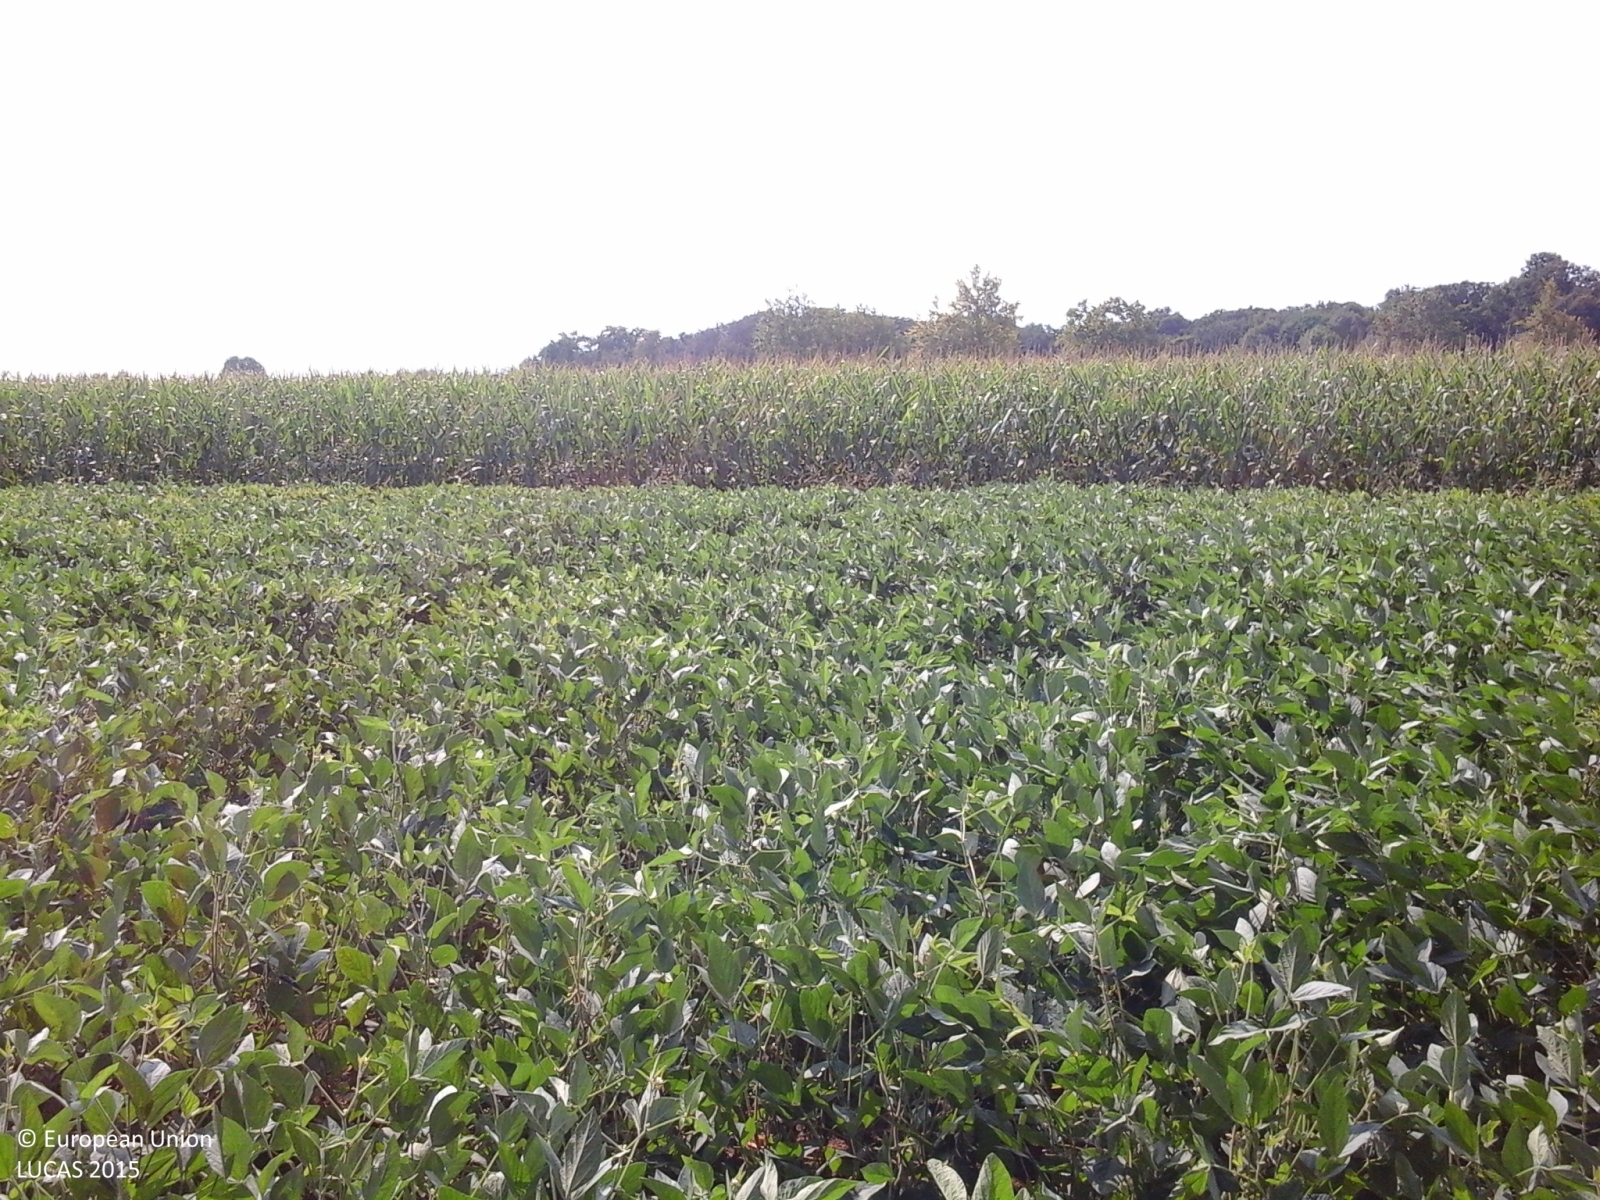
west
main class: Cropland
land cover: Maize
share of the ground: > 75 %
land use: Agriculture (excluding fallow land and kitchen gardens)
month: June
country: IT
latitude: 45.7620
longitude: 12.5551
